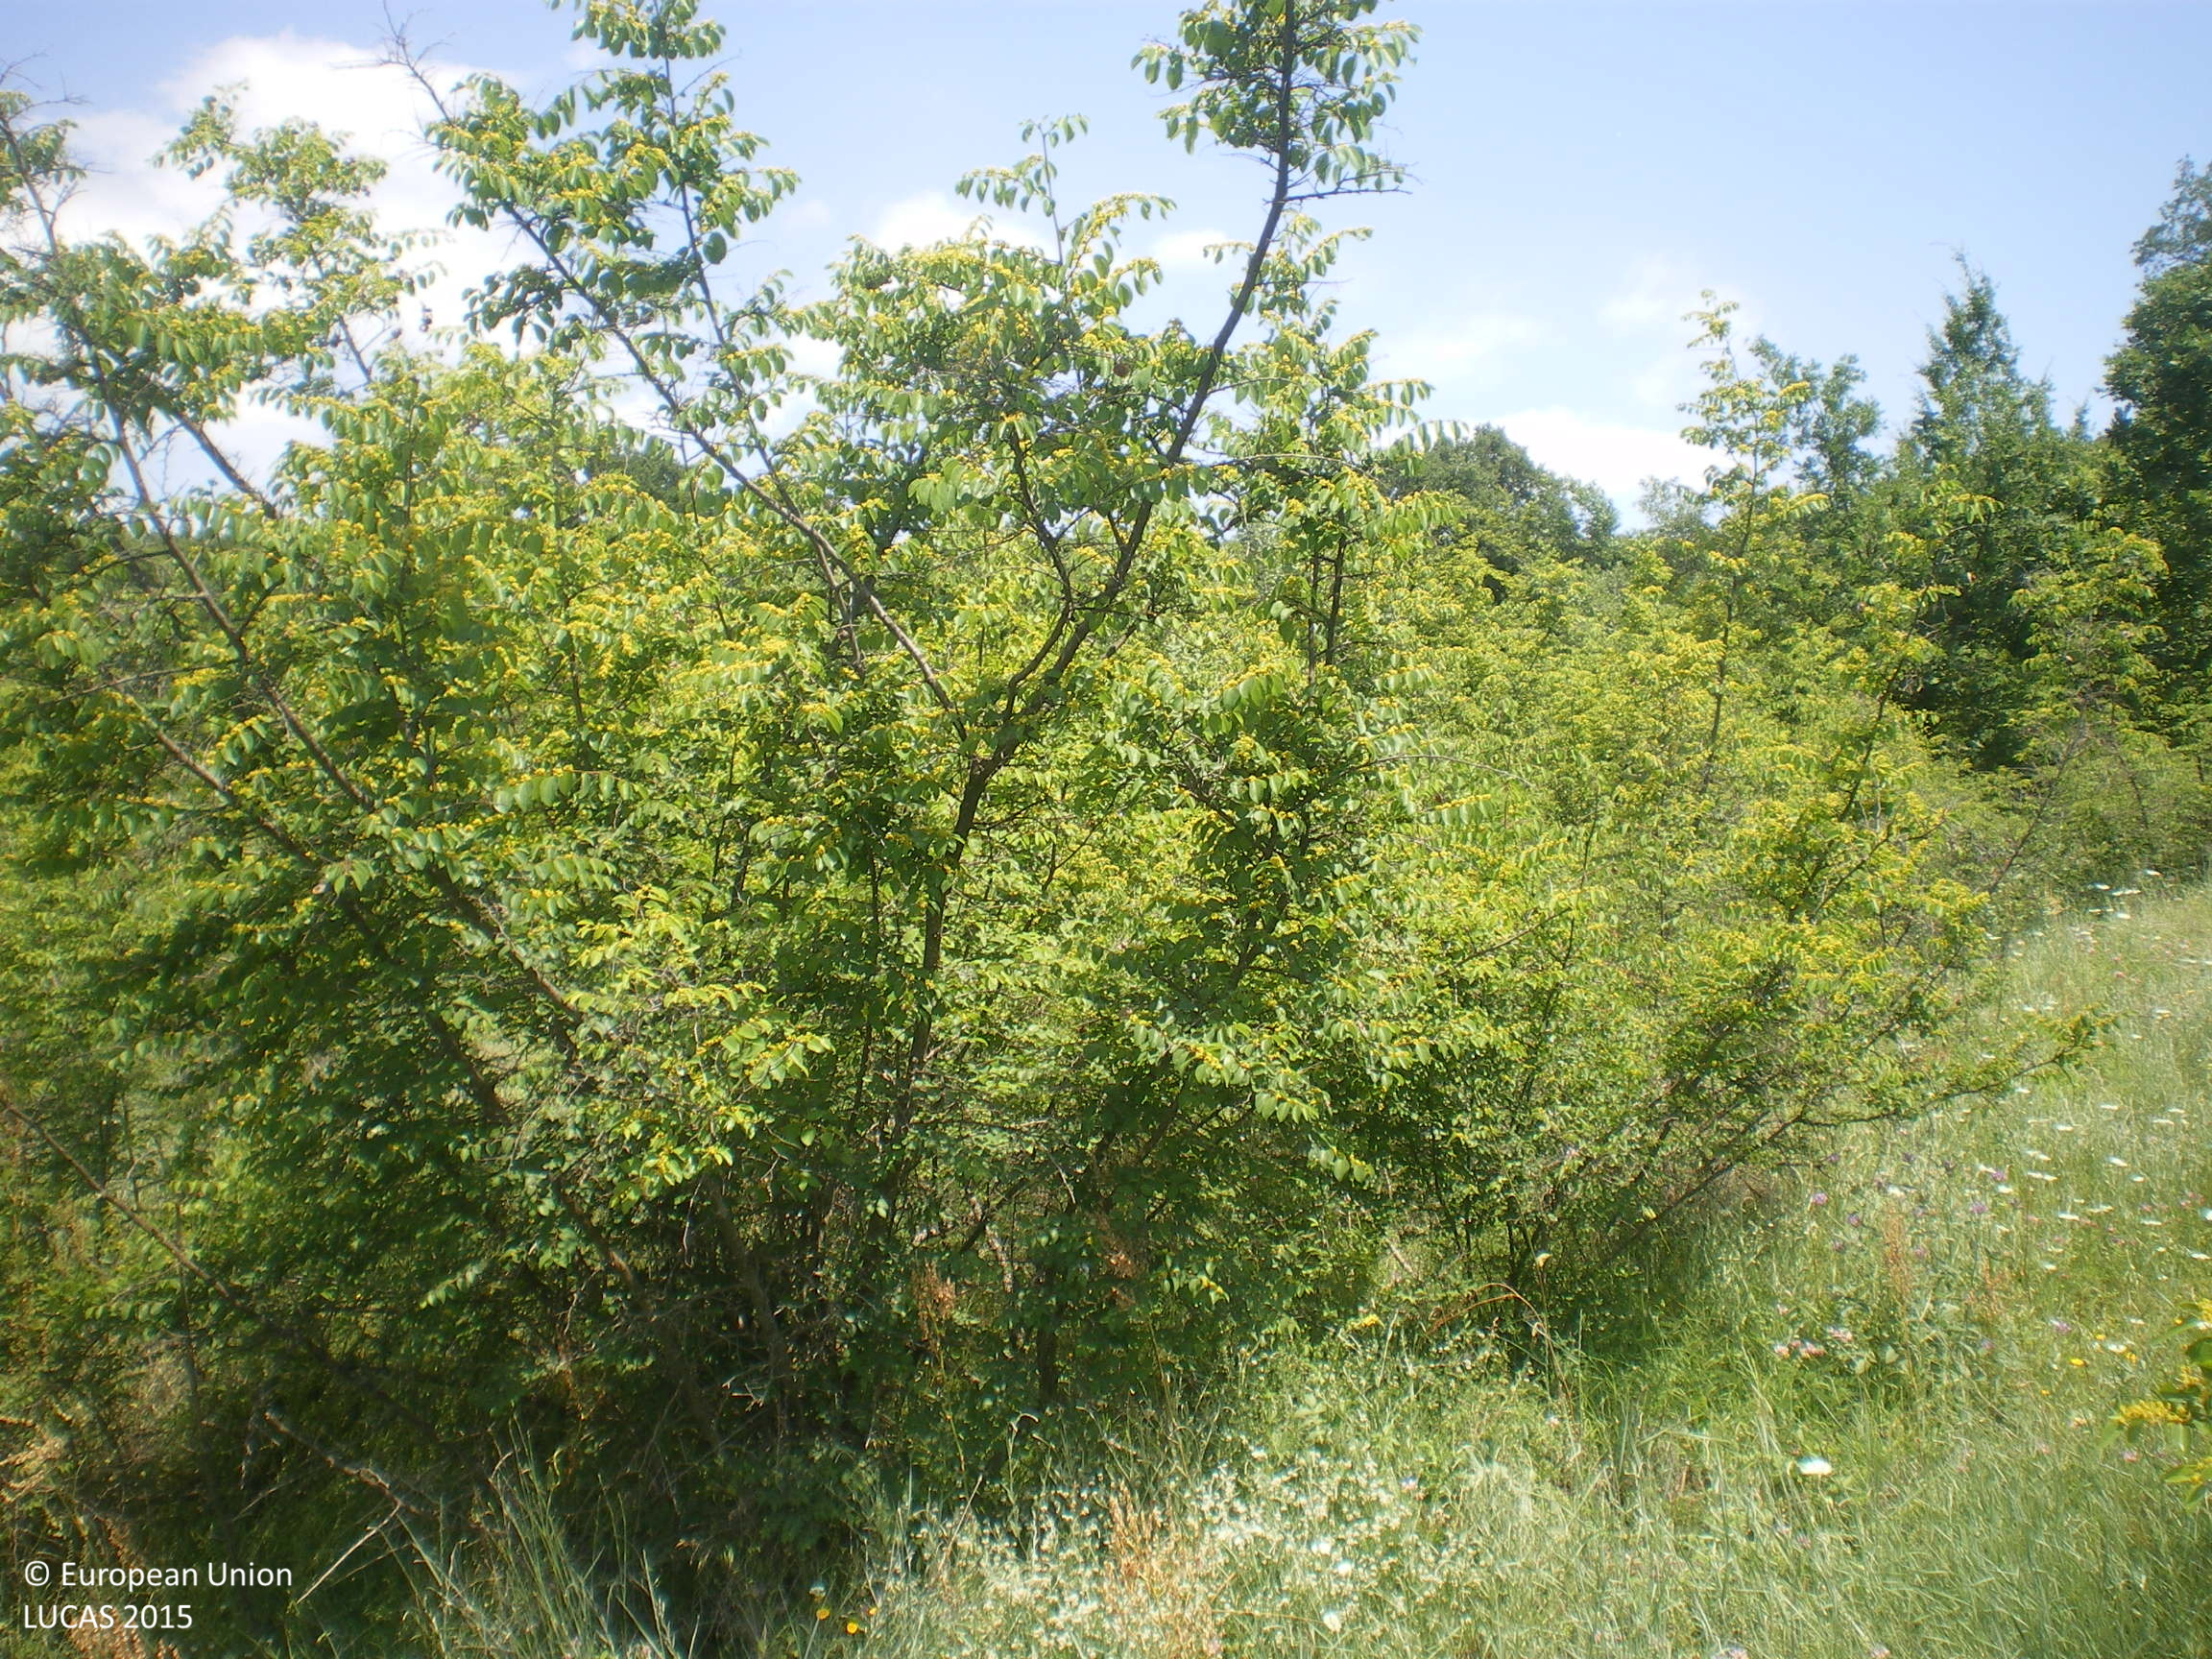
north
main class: Shrubland
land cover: Shrubland with sparse tree cover
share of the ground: 25 - 50 %
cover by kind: shrubs 50 %, herbaceous plants 45 %, broadleaved forest trees 5 %
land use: Fallow land
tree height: > 5 m
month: June
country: BG
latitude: 42.3359
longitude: 25.2462
